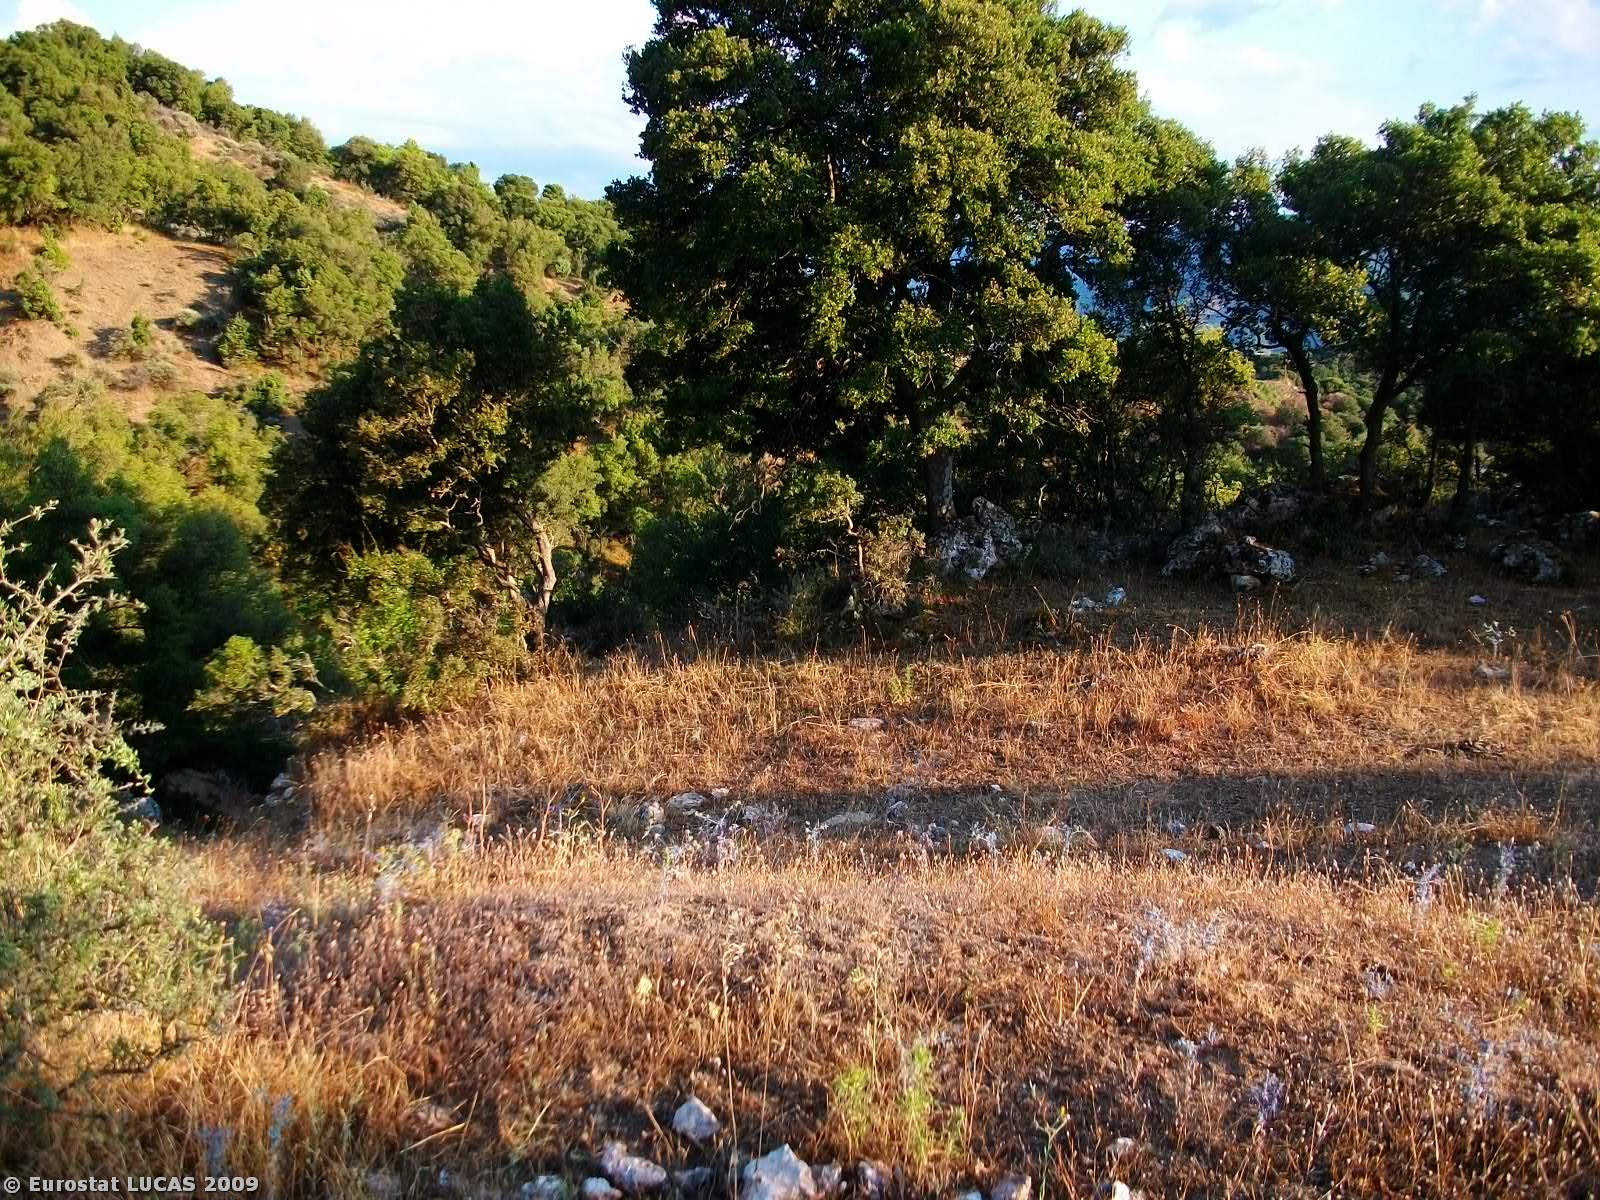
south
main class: Grassland
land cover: Grassland with sparse tree/shrub cover
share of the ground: > 75 %
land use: Agriculture (excluding fallow land and kitchen gardens)
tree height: < 5 m
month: June
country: GR
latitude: 38.5583
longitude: 22.1498
